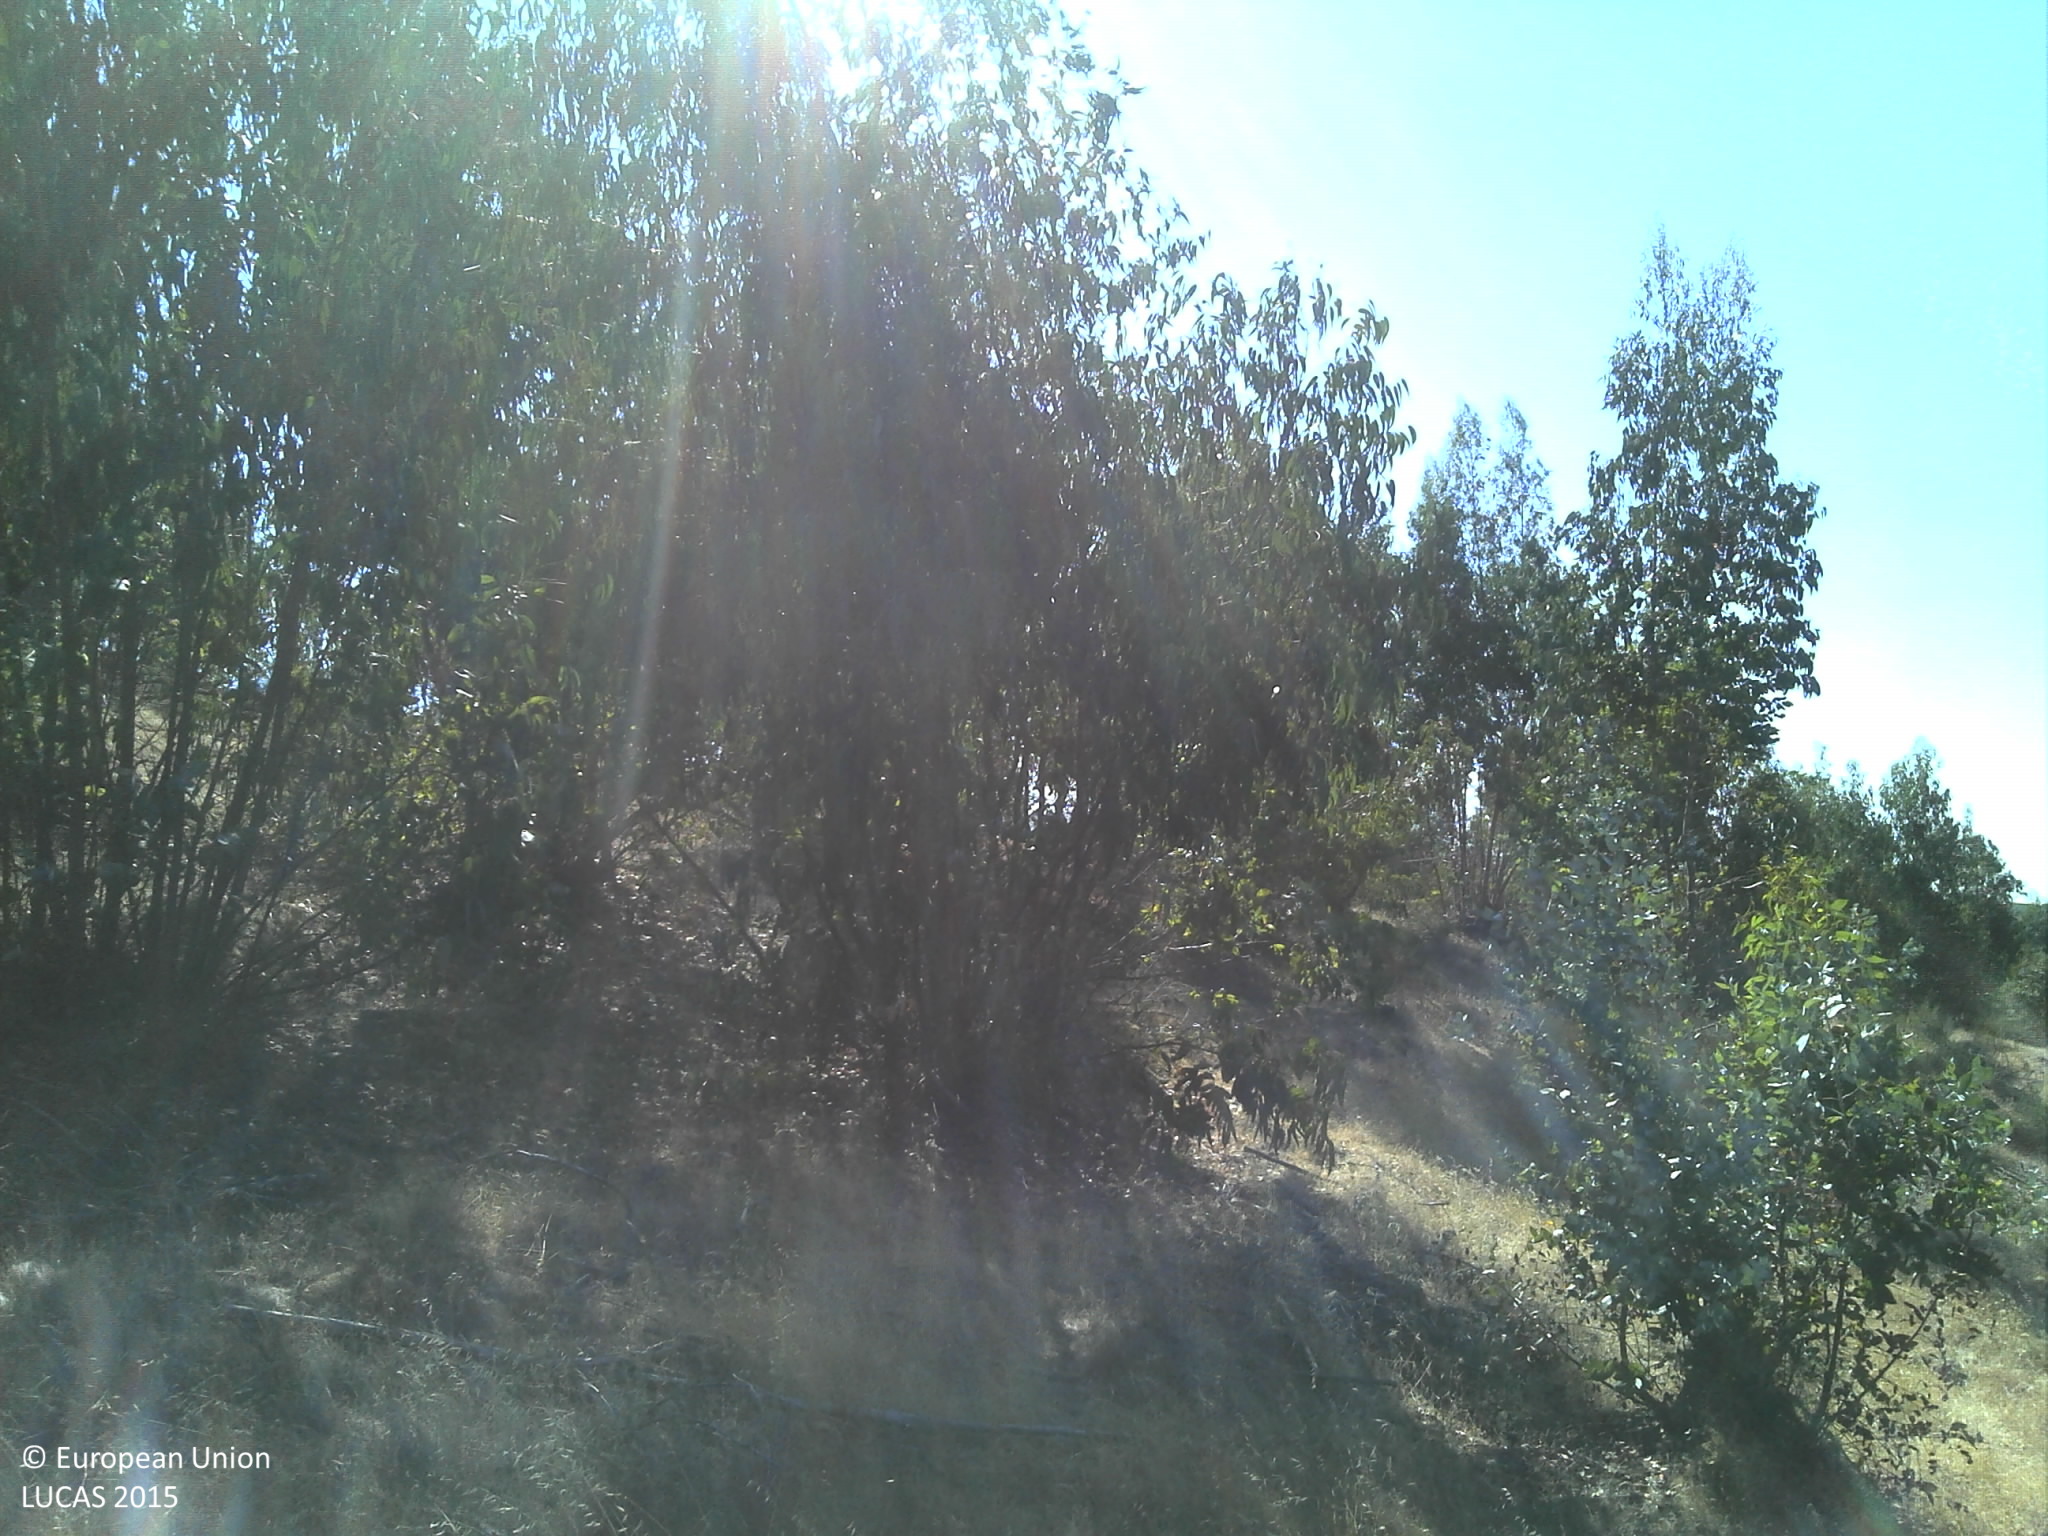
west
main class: Woodland
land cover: Broadleaved woodland
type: exotic forest
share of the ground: 25 - 50 %
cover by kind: unconsolidated bare surface 50 %, broadleaved forest trees 30 %, herbaceous plants 20 %
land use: Forestry
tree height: > 5 m
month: July
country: PT
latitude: 39.0016
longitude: -7.4613
